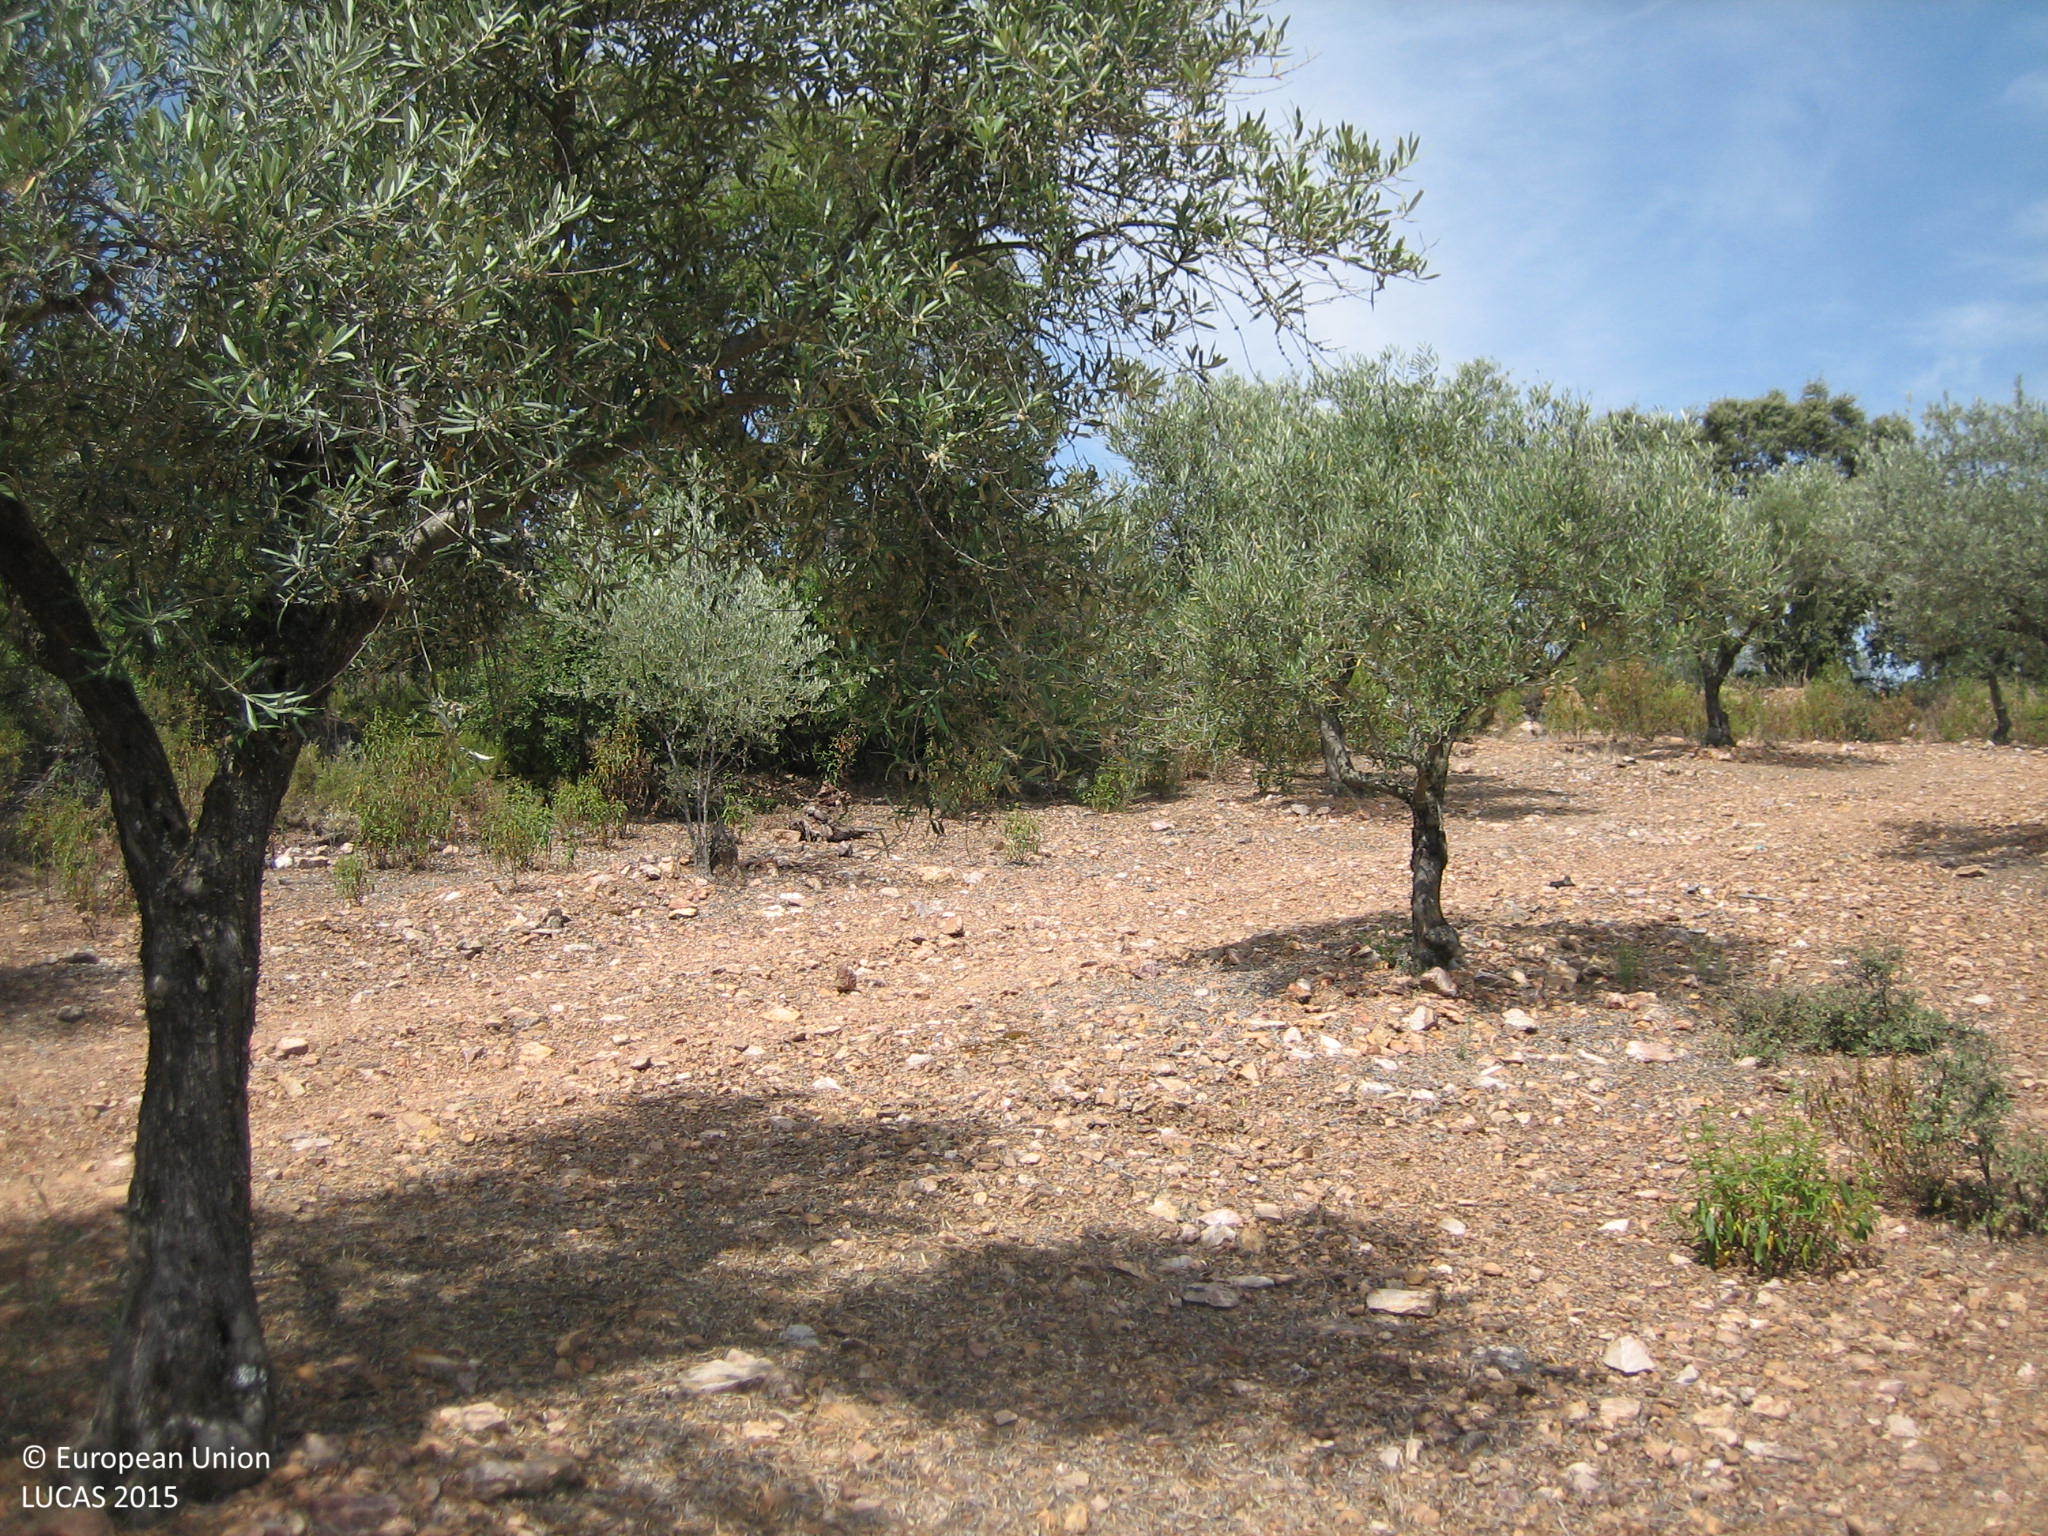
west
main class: Cropland
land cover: Olive groves
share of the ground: 25 - 50 %
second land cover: Other bare soil
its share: > 75 %
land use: Agriculture (excluding fallow land and kitchen gardens)
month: June
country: ES
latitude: 38.9734
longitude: -4.7948
